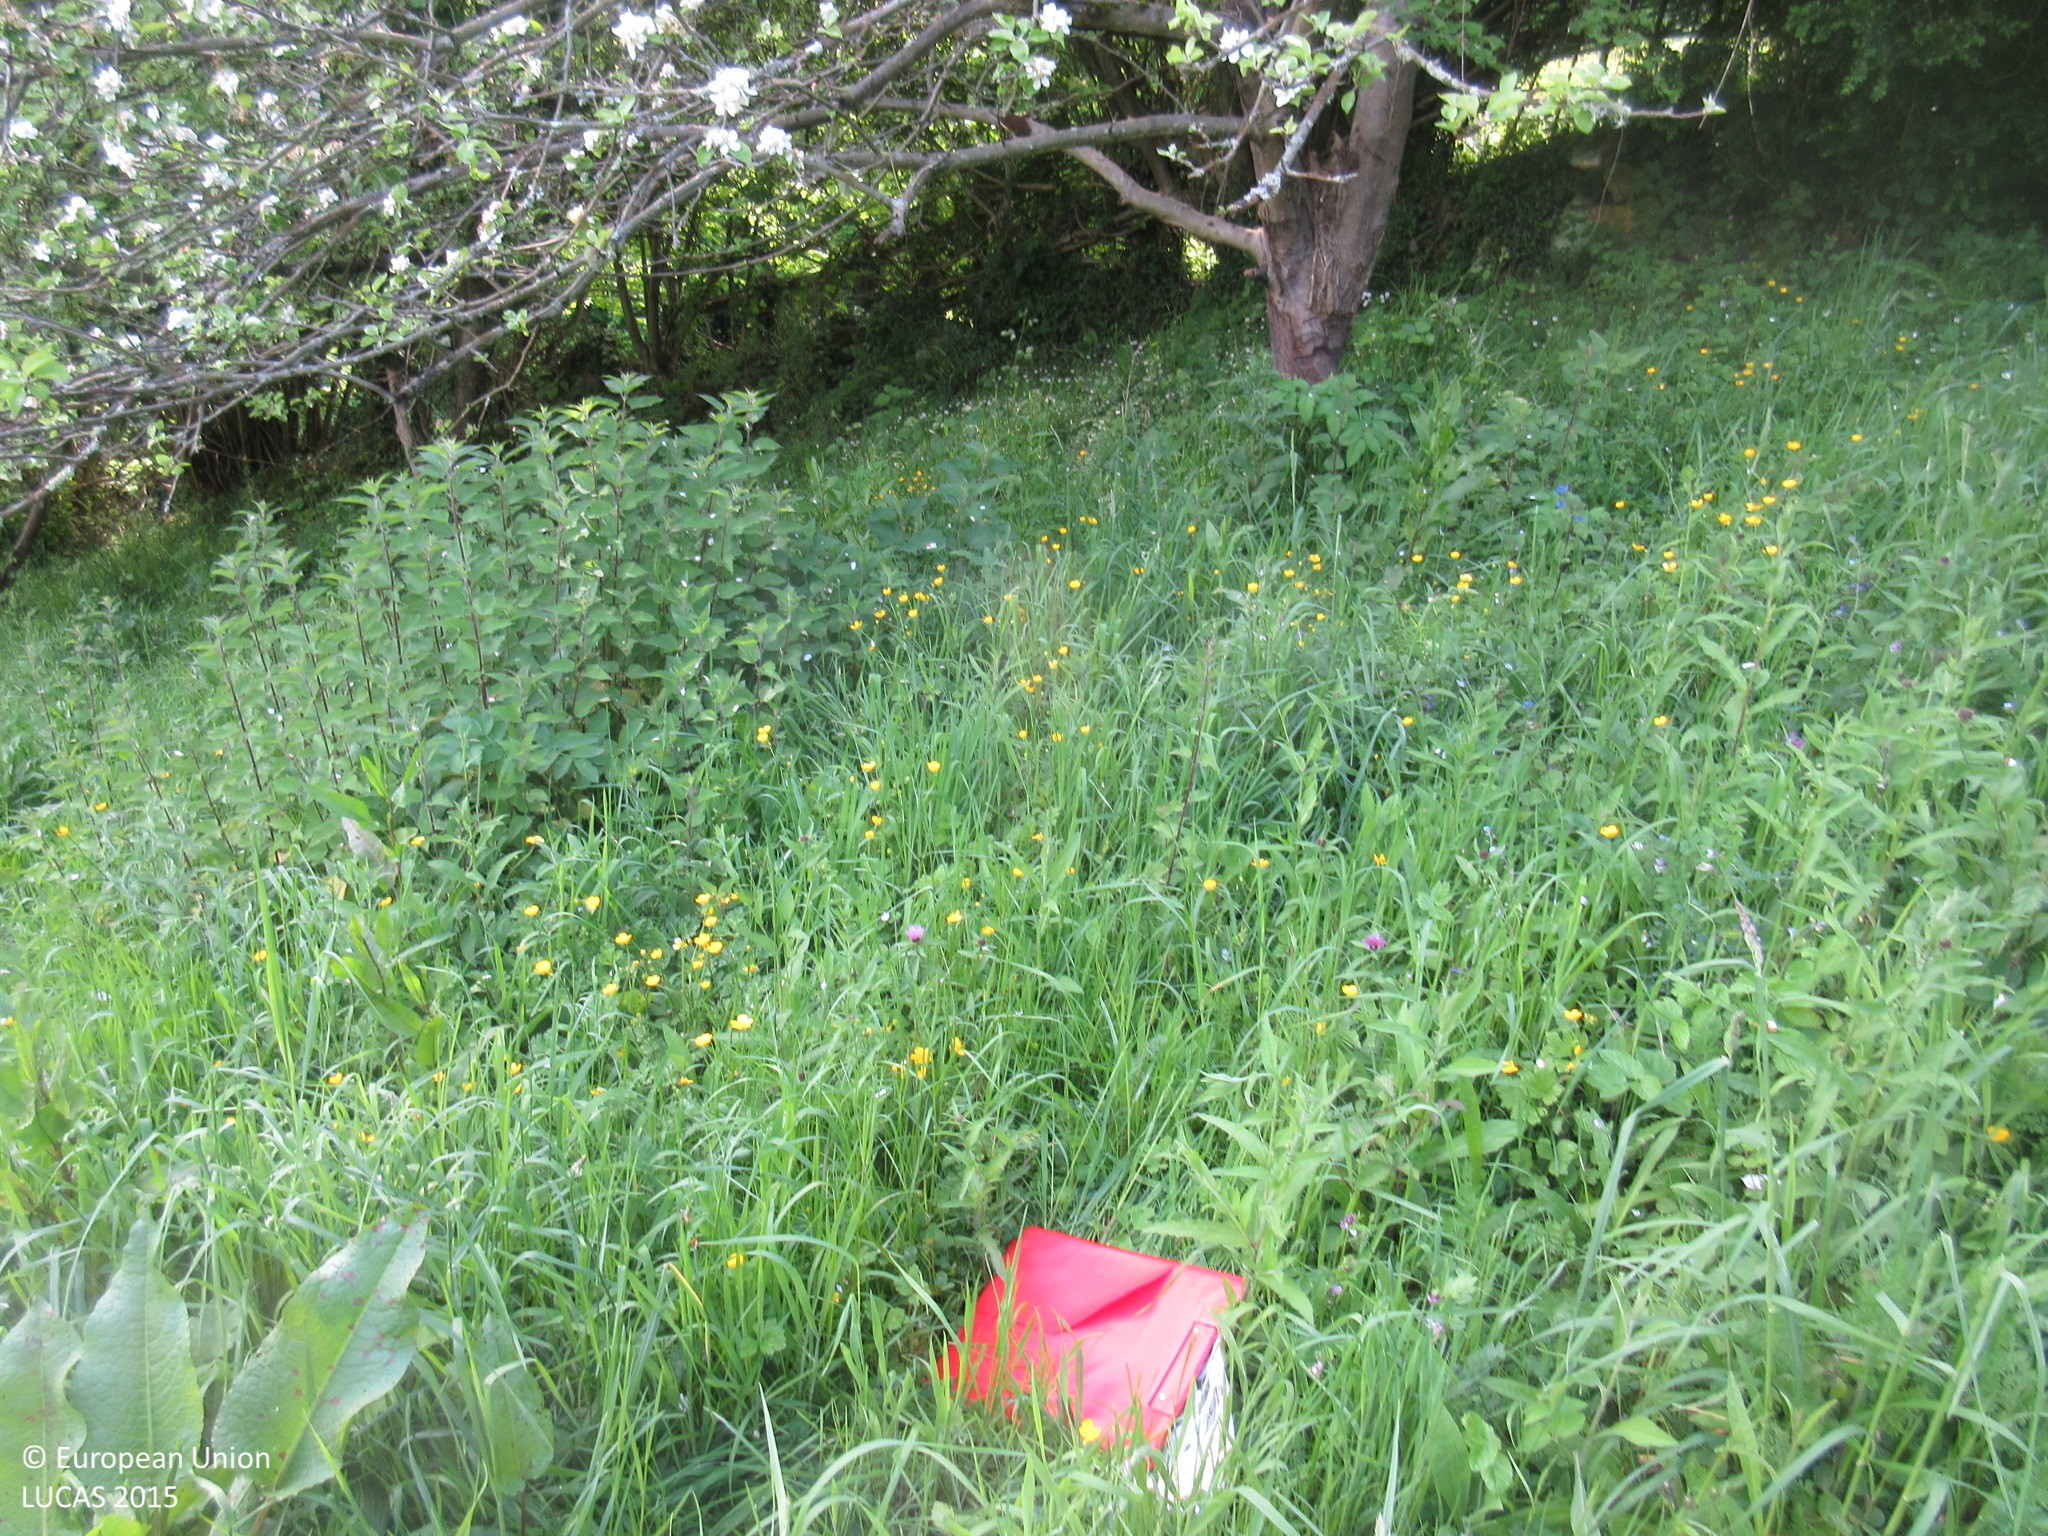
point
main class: Grassland
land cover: Grassland without tree/shrub cover
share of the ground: > 75 %
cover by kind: herbaceous plants 100 %
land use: Agriculture (excluding fallow land and kitchen gardens)
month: May
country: ES
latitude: 43.2593
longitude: -5.9175
